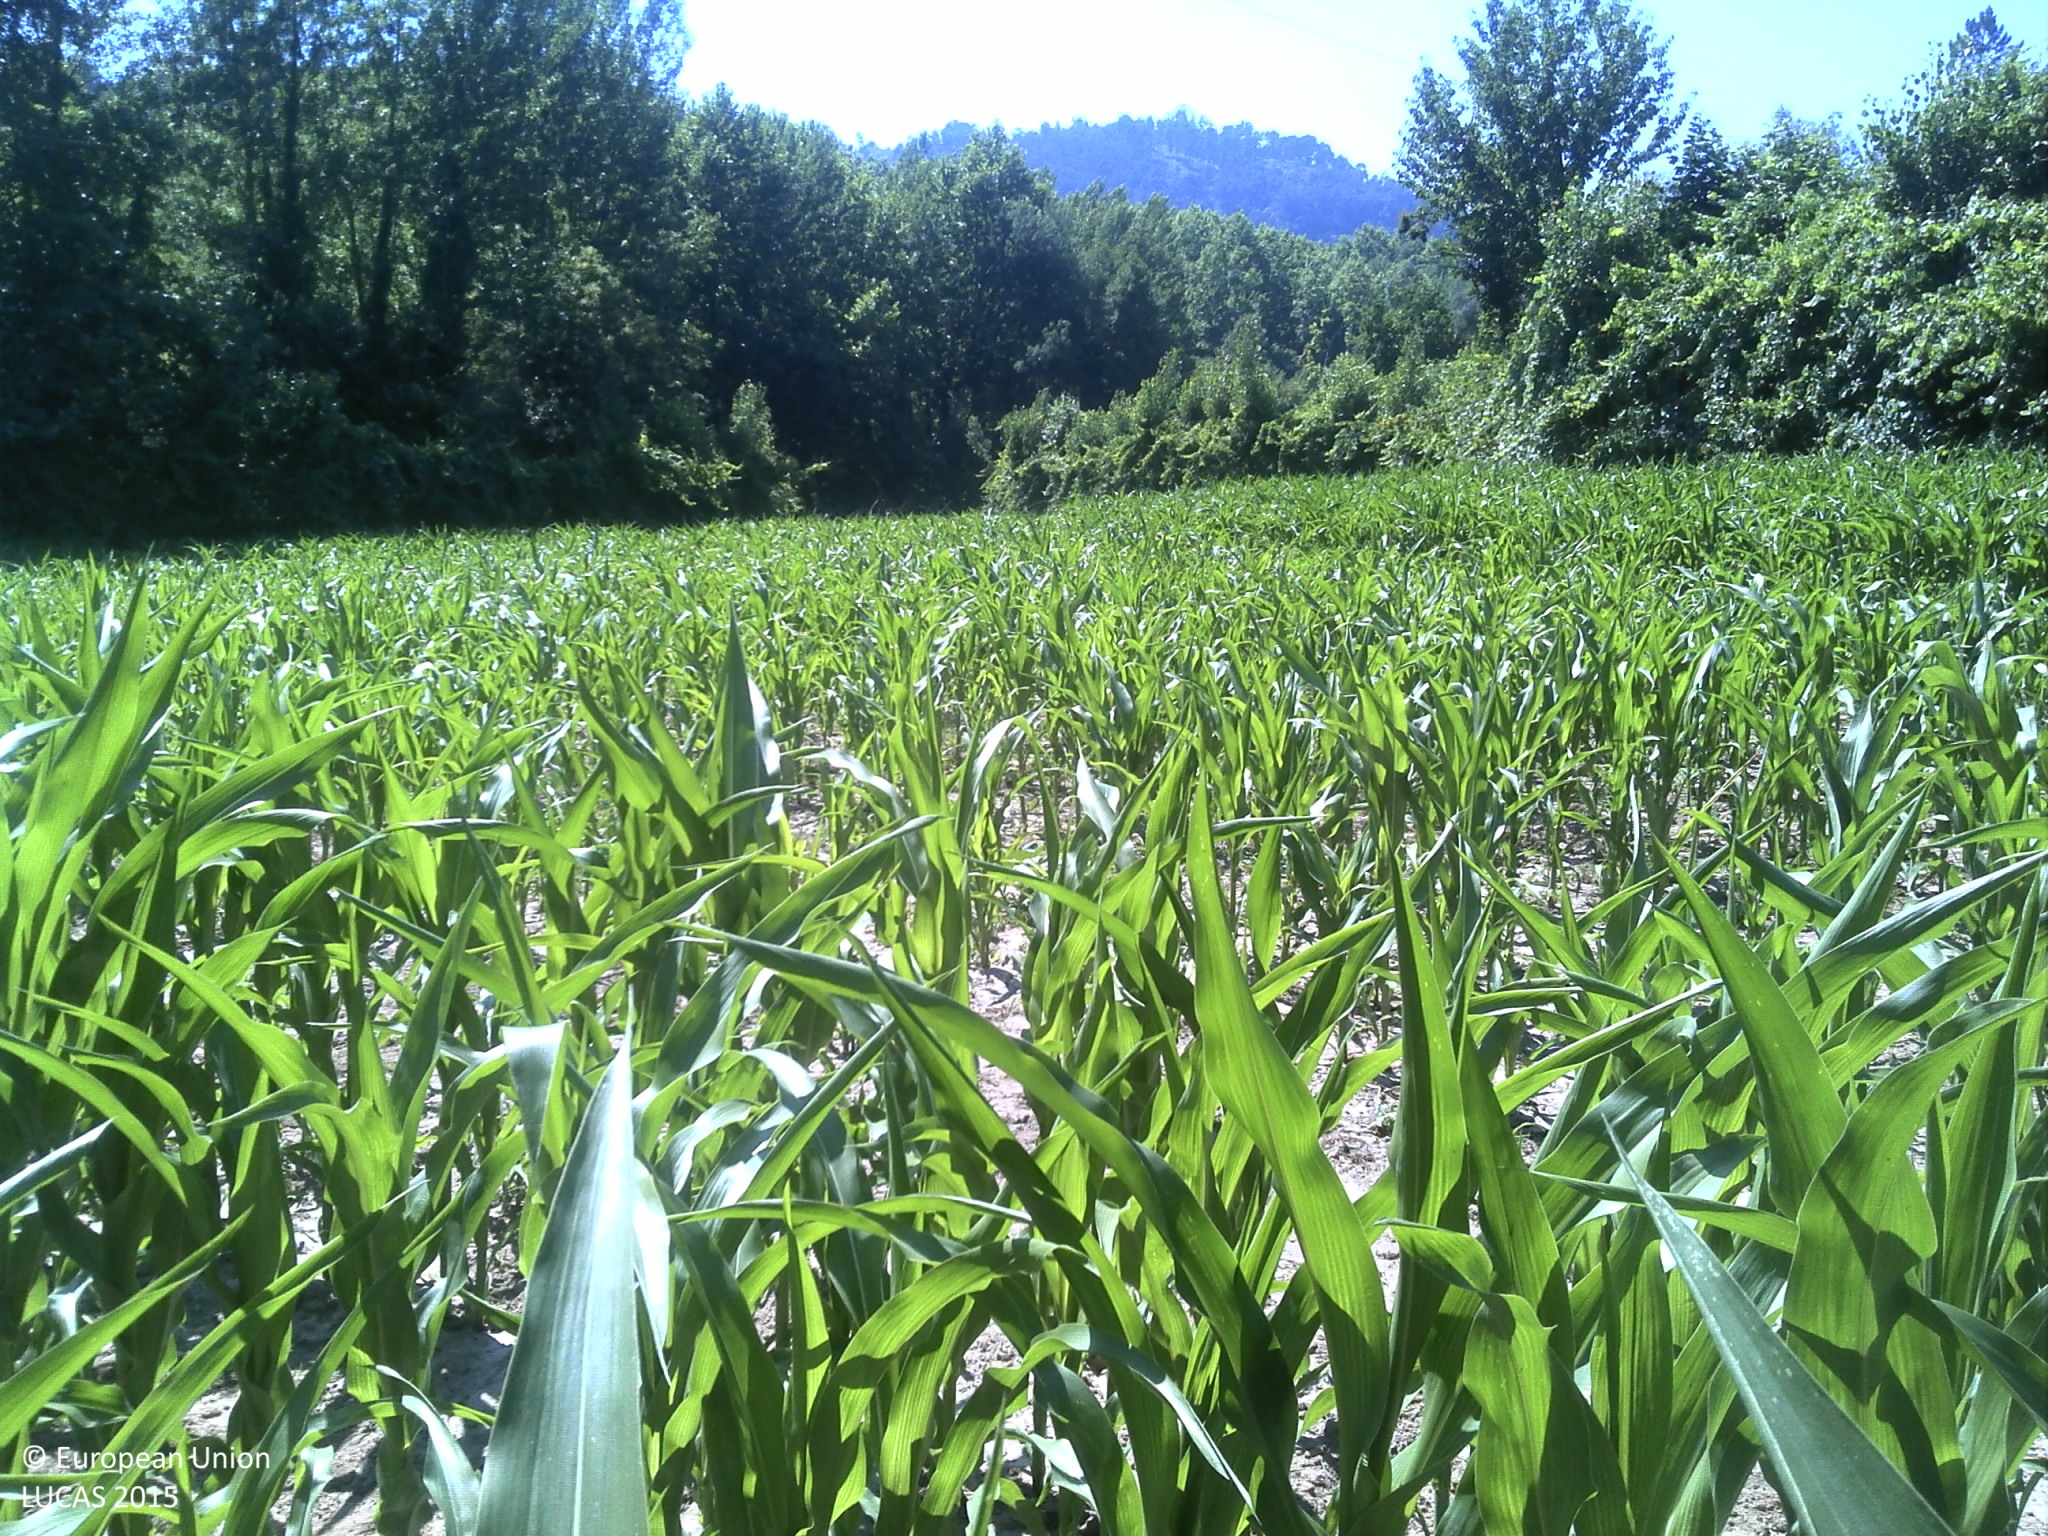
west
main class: Cropland
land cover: Maize
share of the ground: > 75 %
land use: Agriculture (excluding fallow land and kitchen gardens)
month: June
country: PT
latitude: 41.4481
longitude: -8.0114
